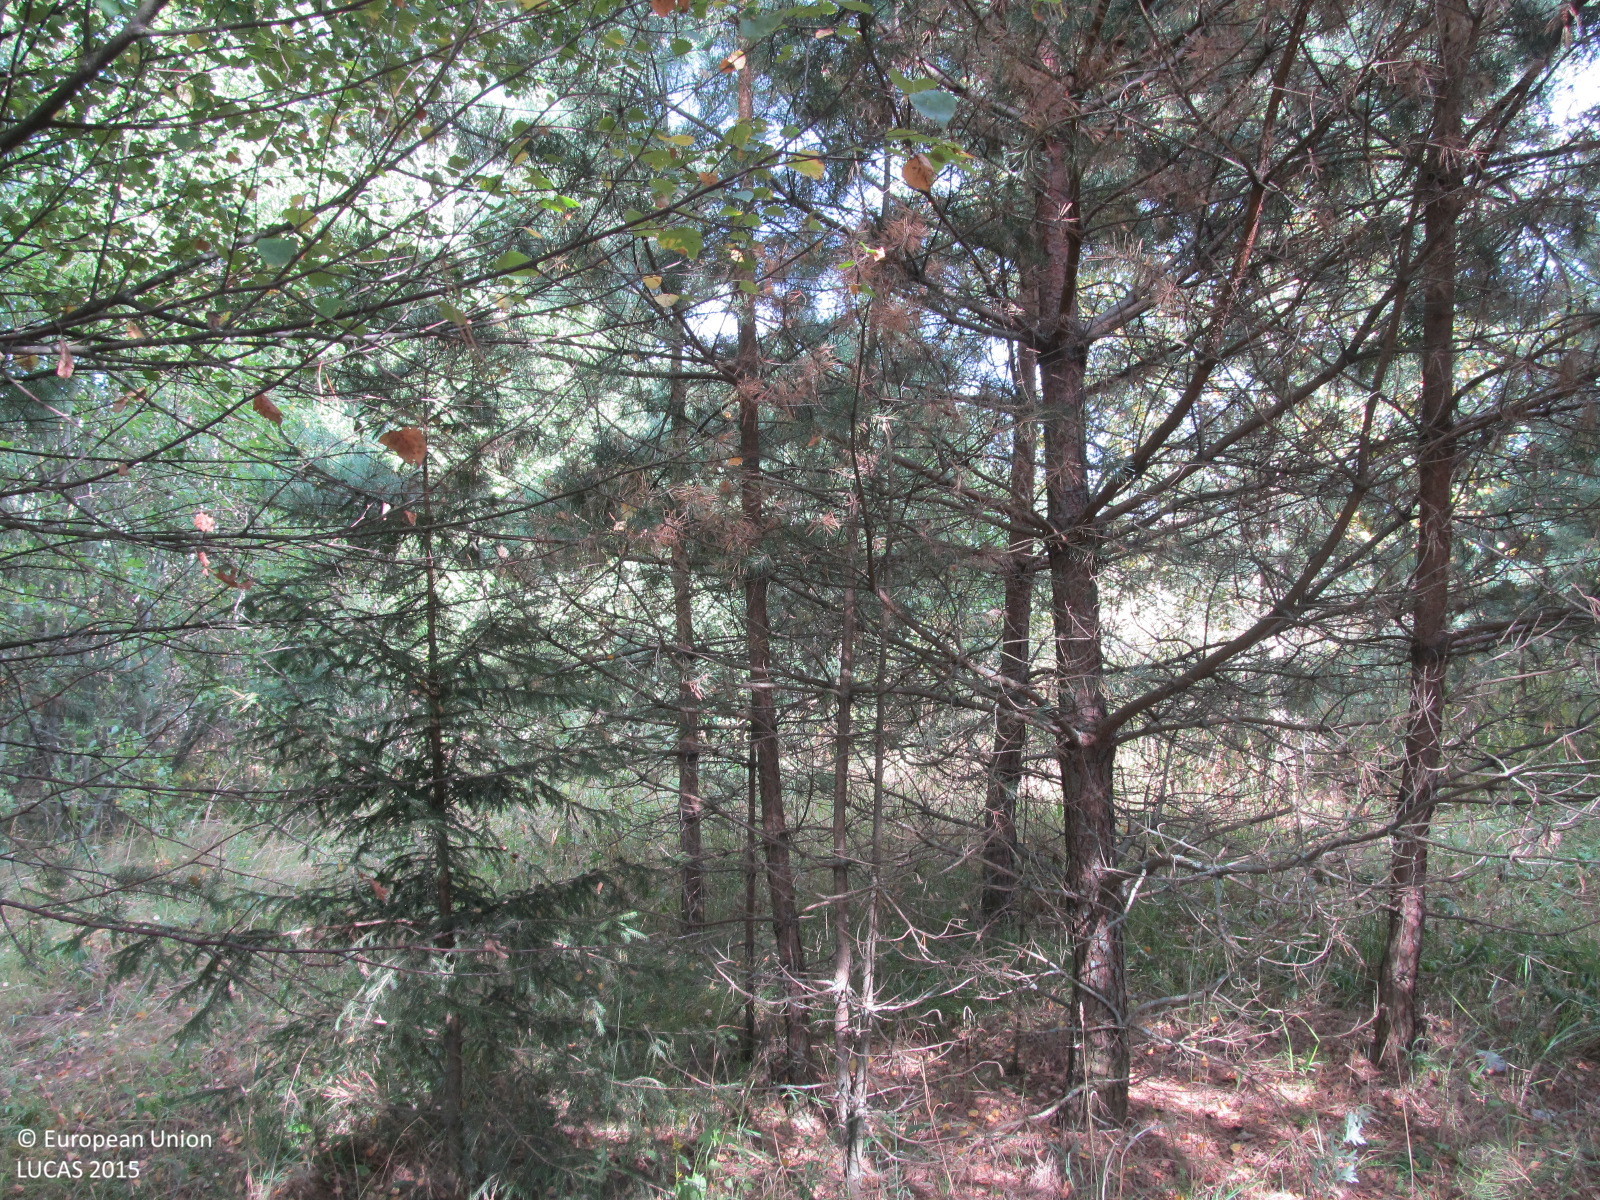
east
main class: Woodland
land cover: Pine dominated coniferous woodland
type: hemiboreal forest and nemoral coniferous forest and mixed broadleaved-coniferous forest
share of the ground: 50 - 75 %
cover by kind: coniferous forest trees 70 %, herbaceous plants 30 %
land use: Forestry
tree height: < 5 m
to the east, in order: Pine dominated coniferous woodland; Grassland with sparse tree/shrub cover; Pine dominated coniferous woodland; Spontaneously vegetated surfaces
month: August
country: LT
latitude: 55.6756
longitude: 22.9323
